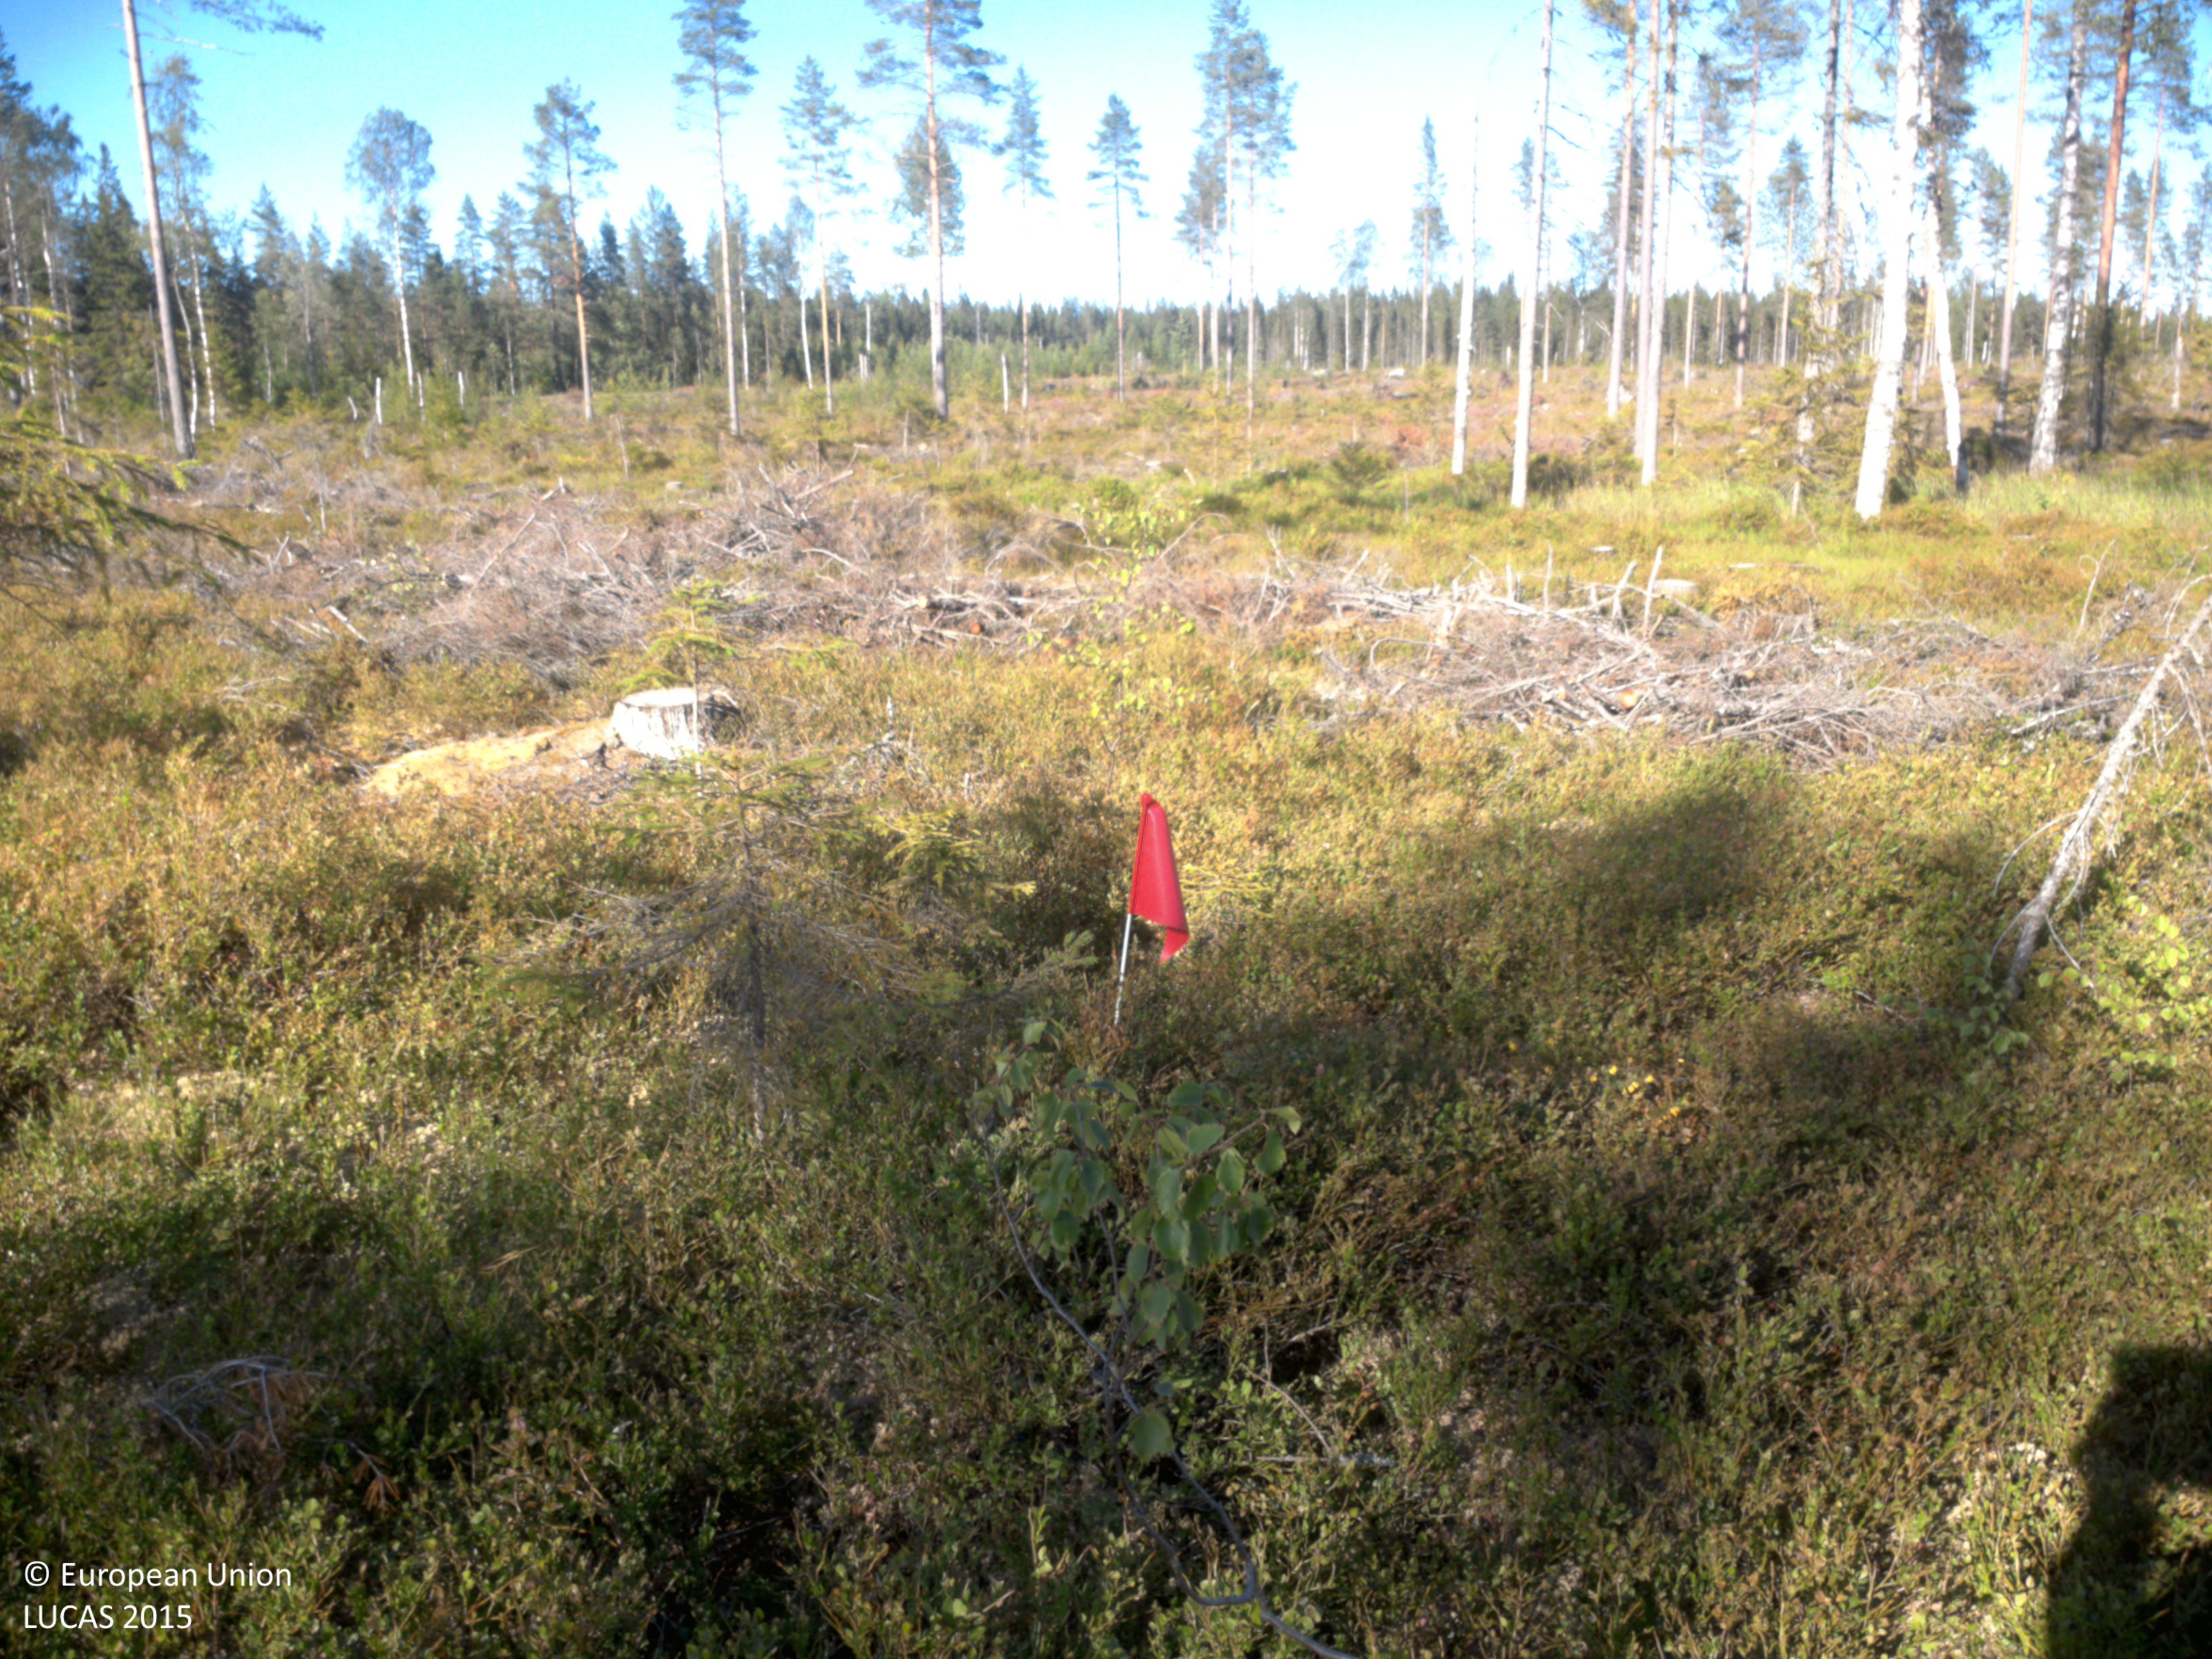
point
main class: Woodland
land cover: Pine dominated coniferous woodland
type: boreal forest
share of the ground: 10 - 25 %
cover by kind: shrubs 45 %, lichens and mosses 40 %, coniferous forest trees 15 %
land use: Forestry
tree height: > 5 m
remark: Clear cut
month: August
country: SE
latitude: 63.6969
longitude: 19.7495
